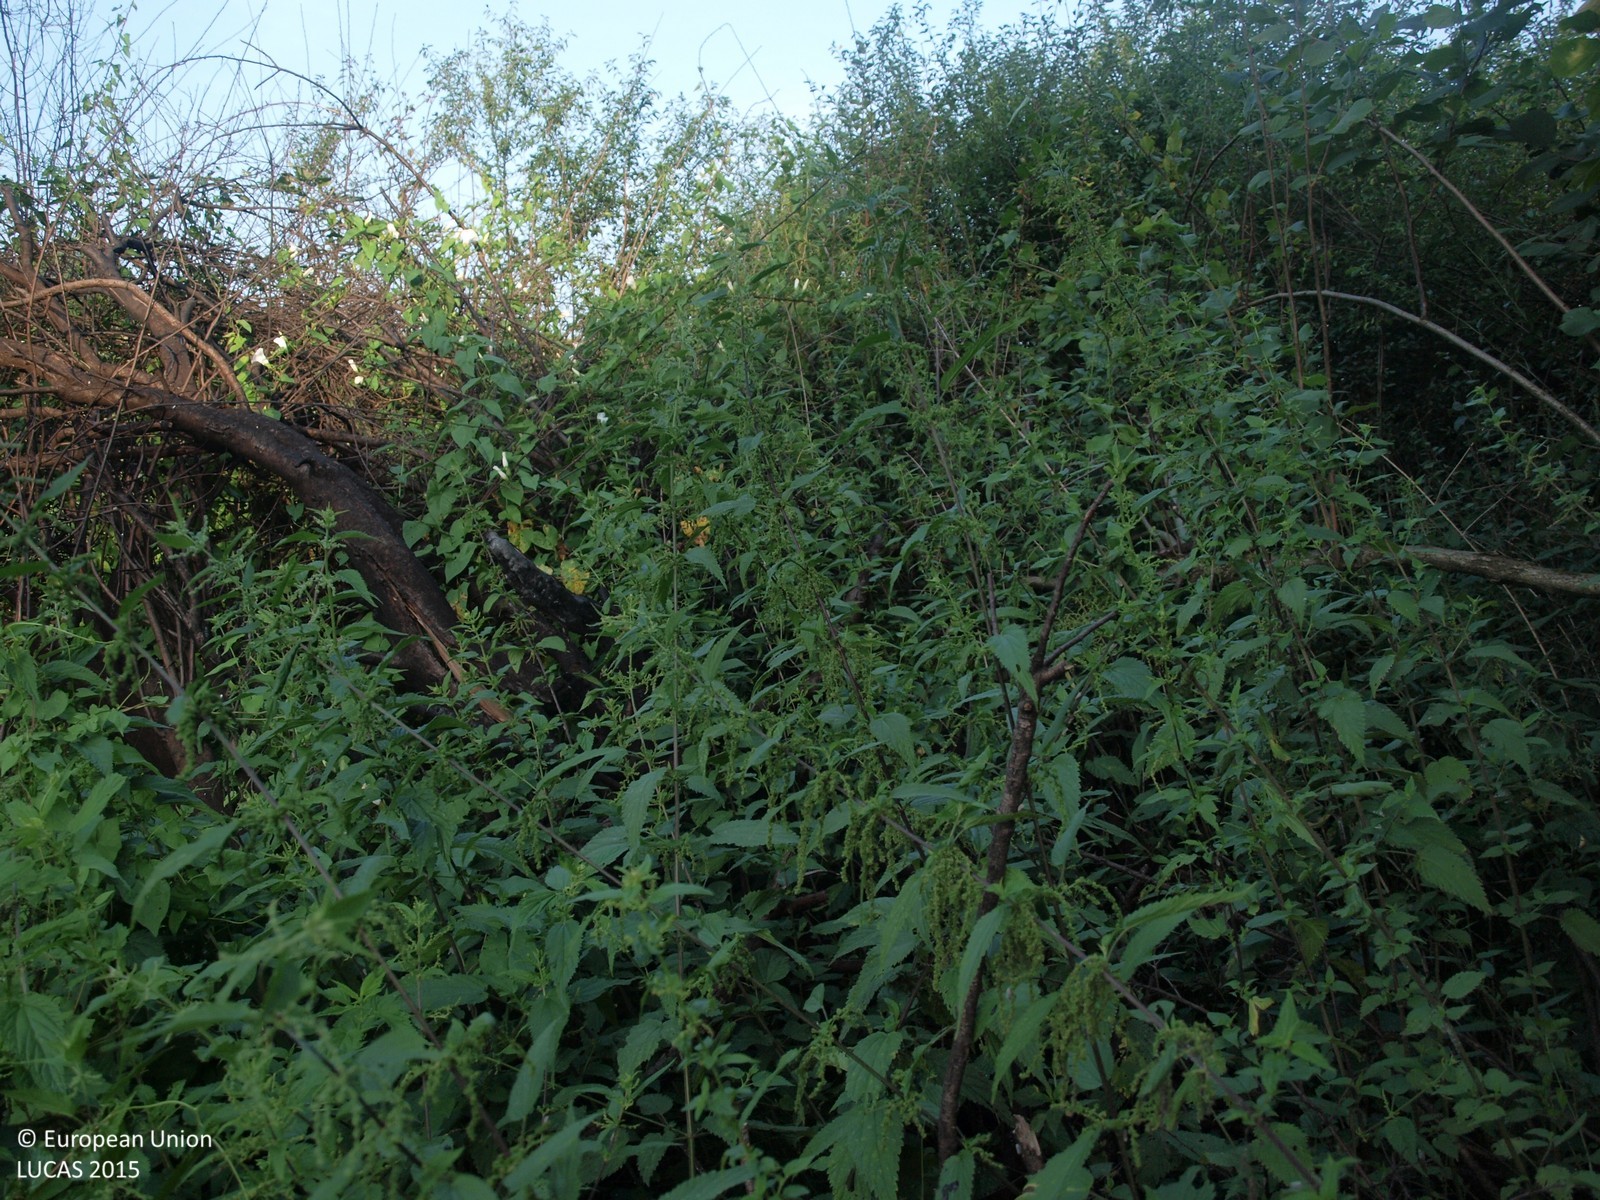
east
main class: Shrubland
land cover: Shrubland with sparse tree cover
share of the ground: > 75 %
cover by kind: shrubs 95 %, broadleaved forest trees 5 %
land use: Semi-natural and natural areas not in use
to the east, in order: Shrubland with sparse tree cover; Grassland without tree/shrub cover; Maize; Grassland without tree/shrub cover; Tracks; Nuts trees; Maize; Abandoned hedges; Barley
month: August
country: HR
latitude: 45.9692
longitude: 16.2580
